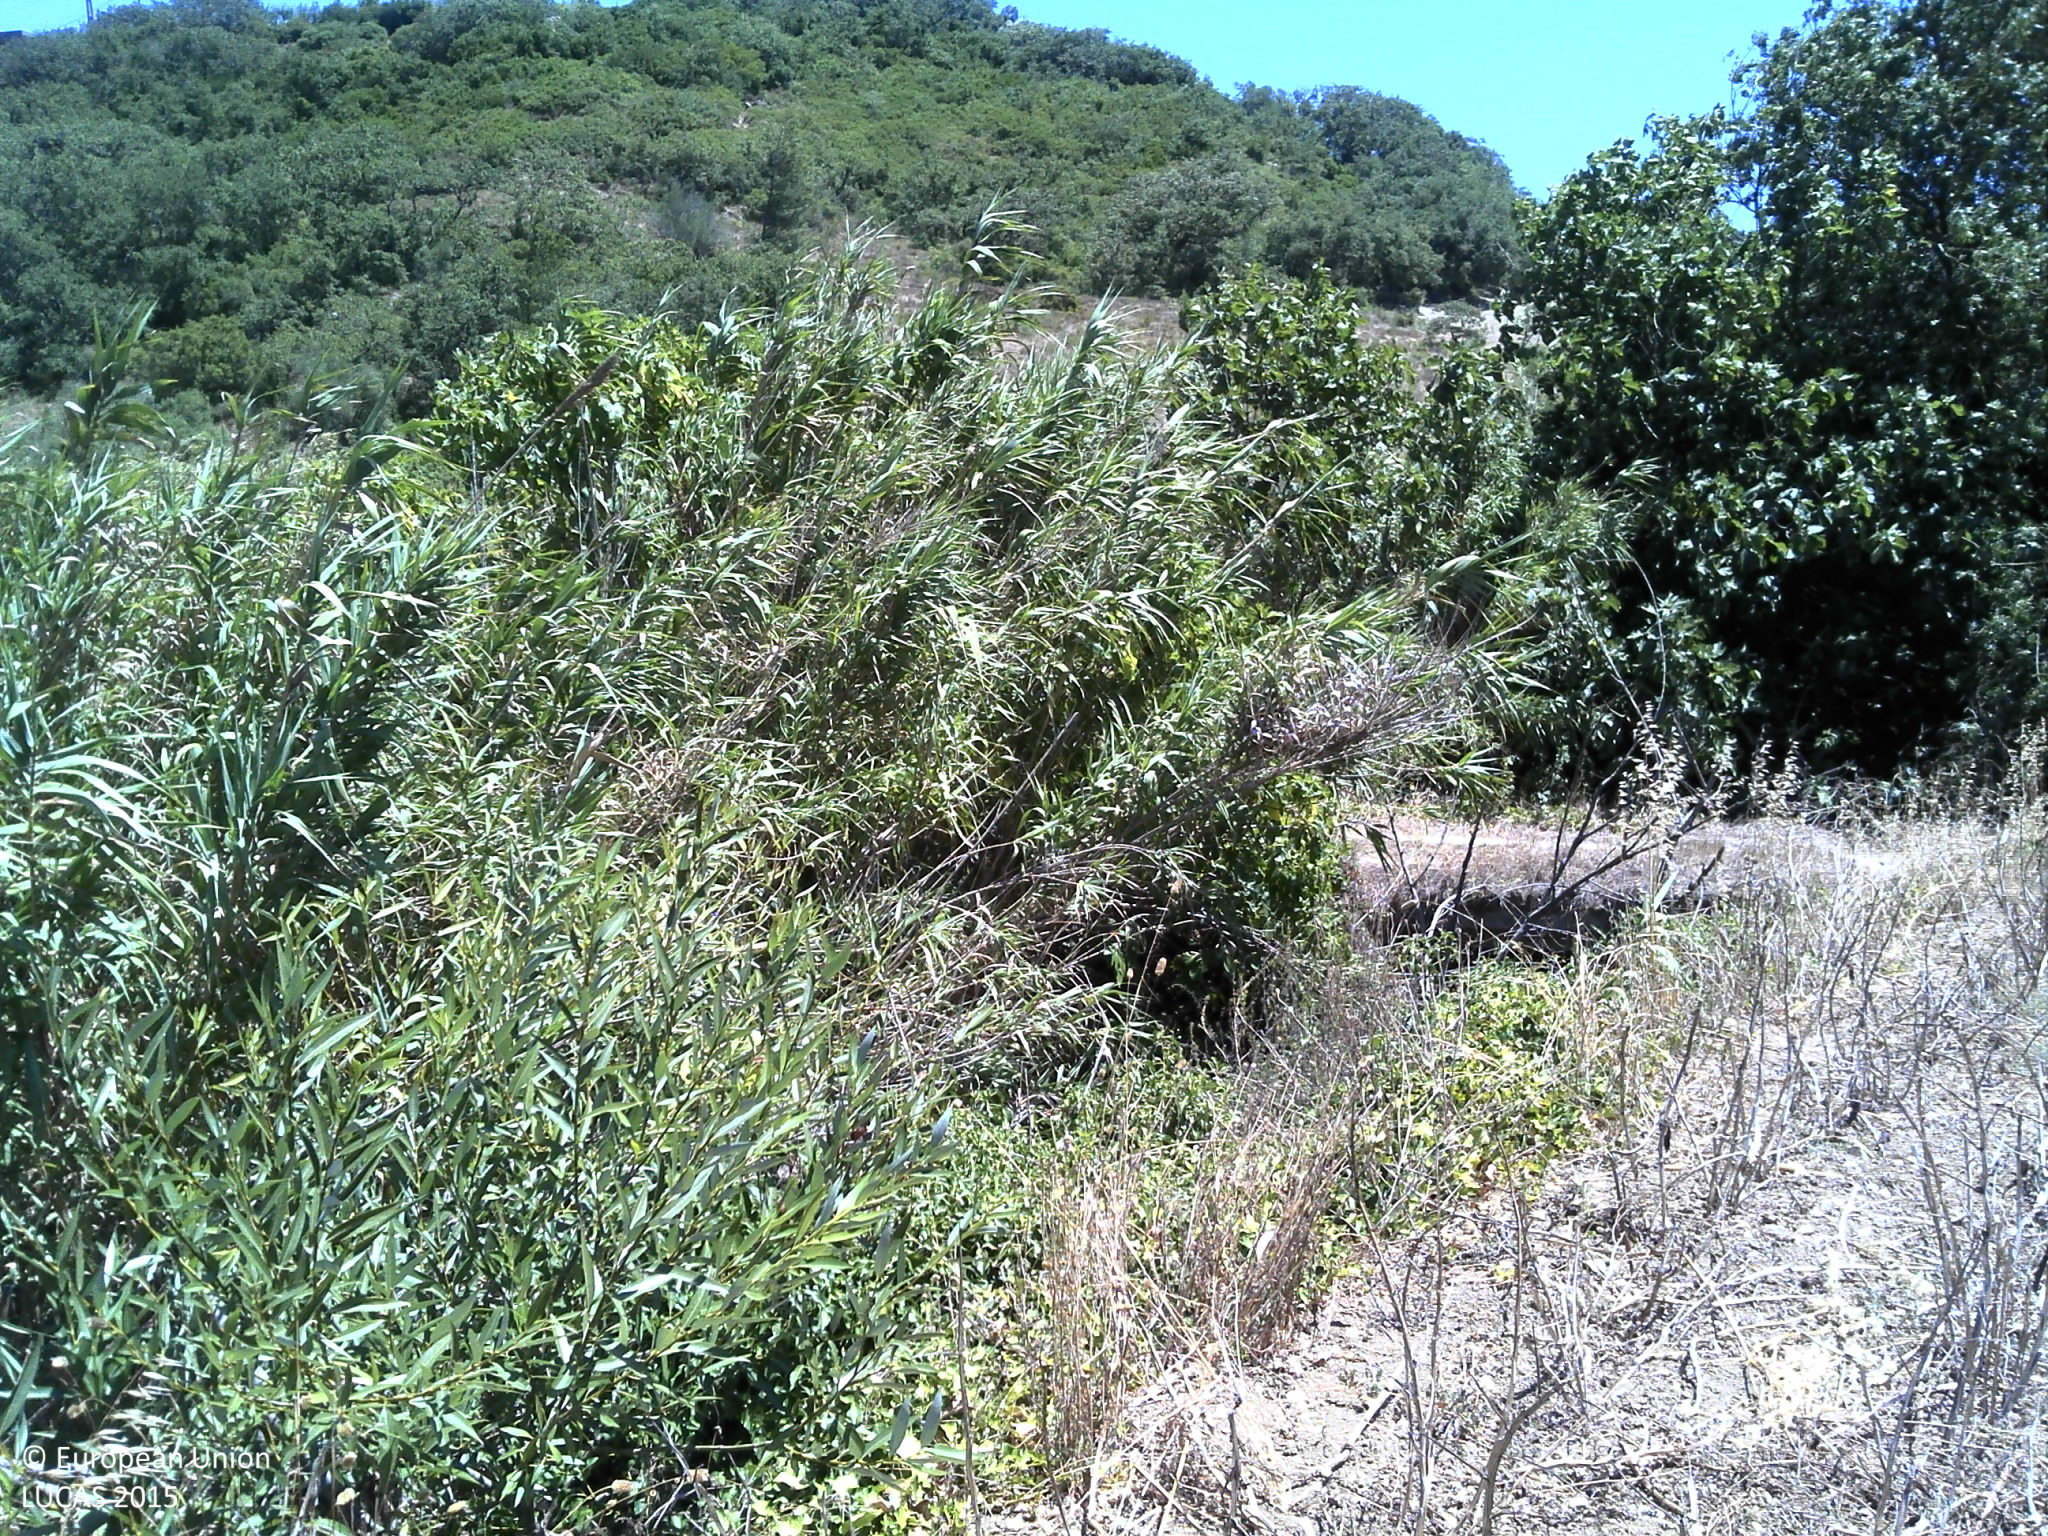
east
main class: Shrubland
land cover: Shrubland with sparse tree cover
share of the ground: 50 - 75 %
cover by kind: shrubs 50 %, herbaceous plants 25 %, coniferous forest trees 5 %, unconsolidated bare surface 5 %
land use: Forestry
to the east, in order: Shrubland with sparse tree cover; Electric lines; Shrubland without tree cover; Olive groves; Tracks; Shruby margins; Other root crops; Dry stone walls; Other root crops; Shrubland without tree cover; Rivers and streams; Shruby margins; Other fresh vegetables; Tracks; Abandoned hedges; Grassland without tree/shrub cover
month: July
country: PT
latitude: 38.9486
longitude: -9.1769
